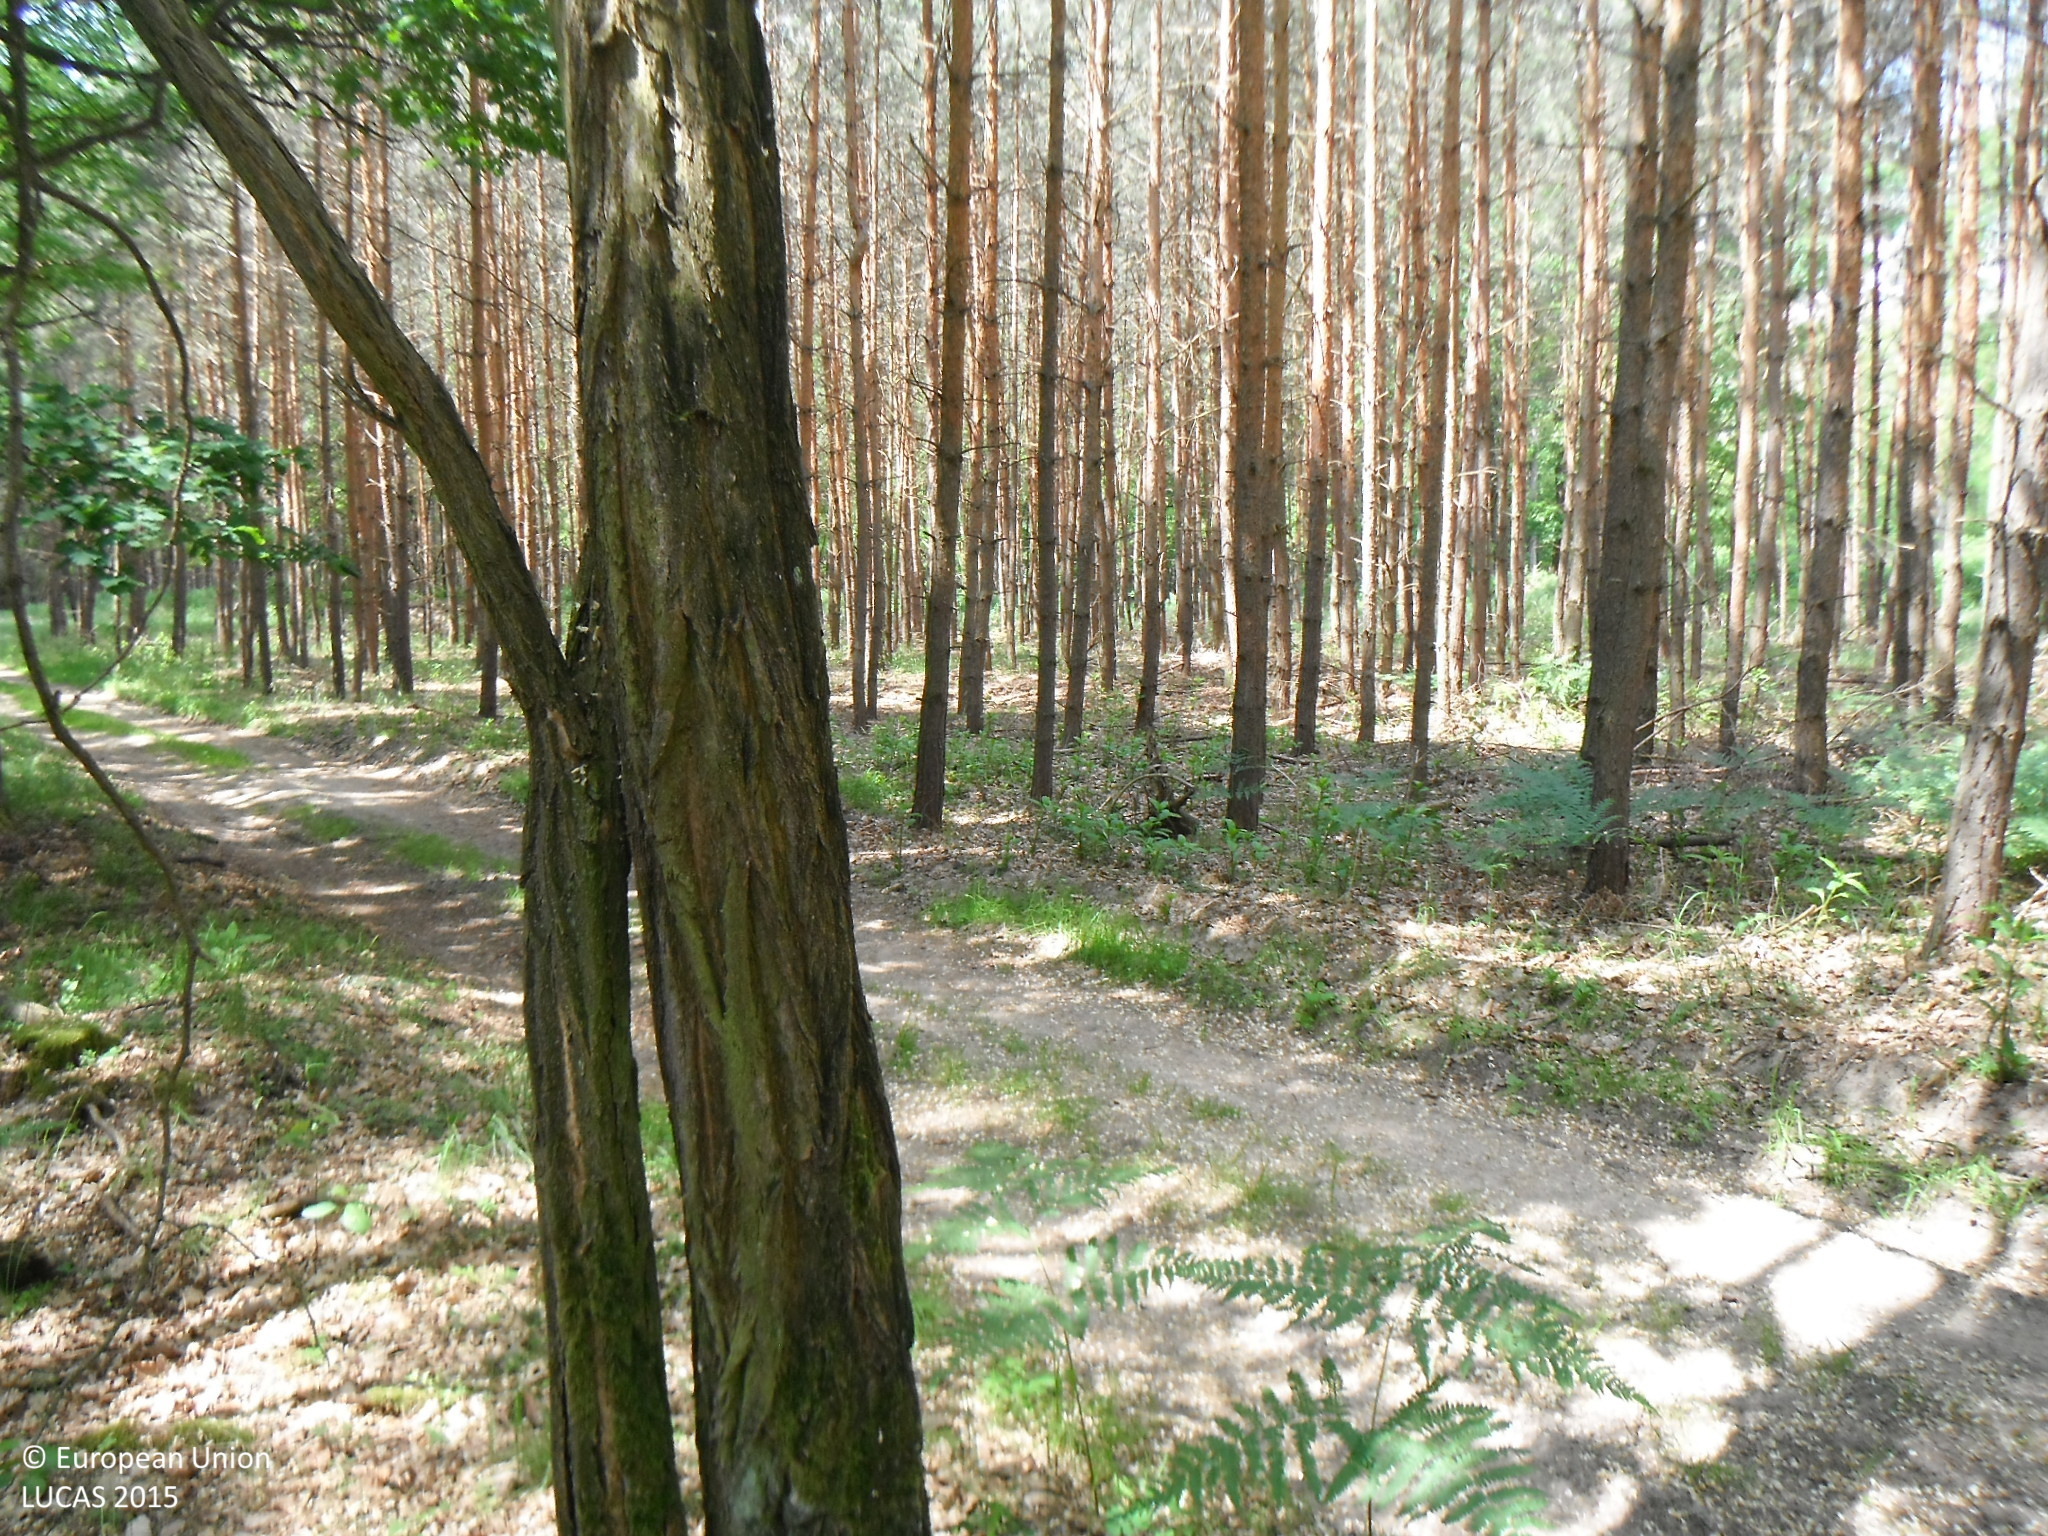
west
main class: Woodland
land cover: Broadleaved woodland
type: exotic forest
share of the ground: > 75 %
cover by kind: broadleaved forest trees 85 %, shrubs 5 %, herbaceous plants 5 %, unconsolidated bare surface 5 %
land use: Forestry
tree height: > 5 m
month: June
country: SK
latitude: 48.5513
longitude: 17.1484
